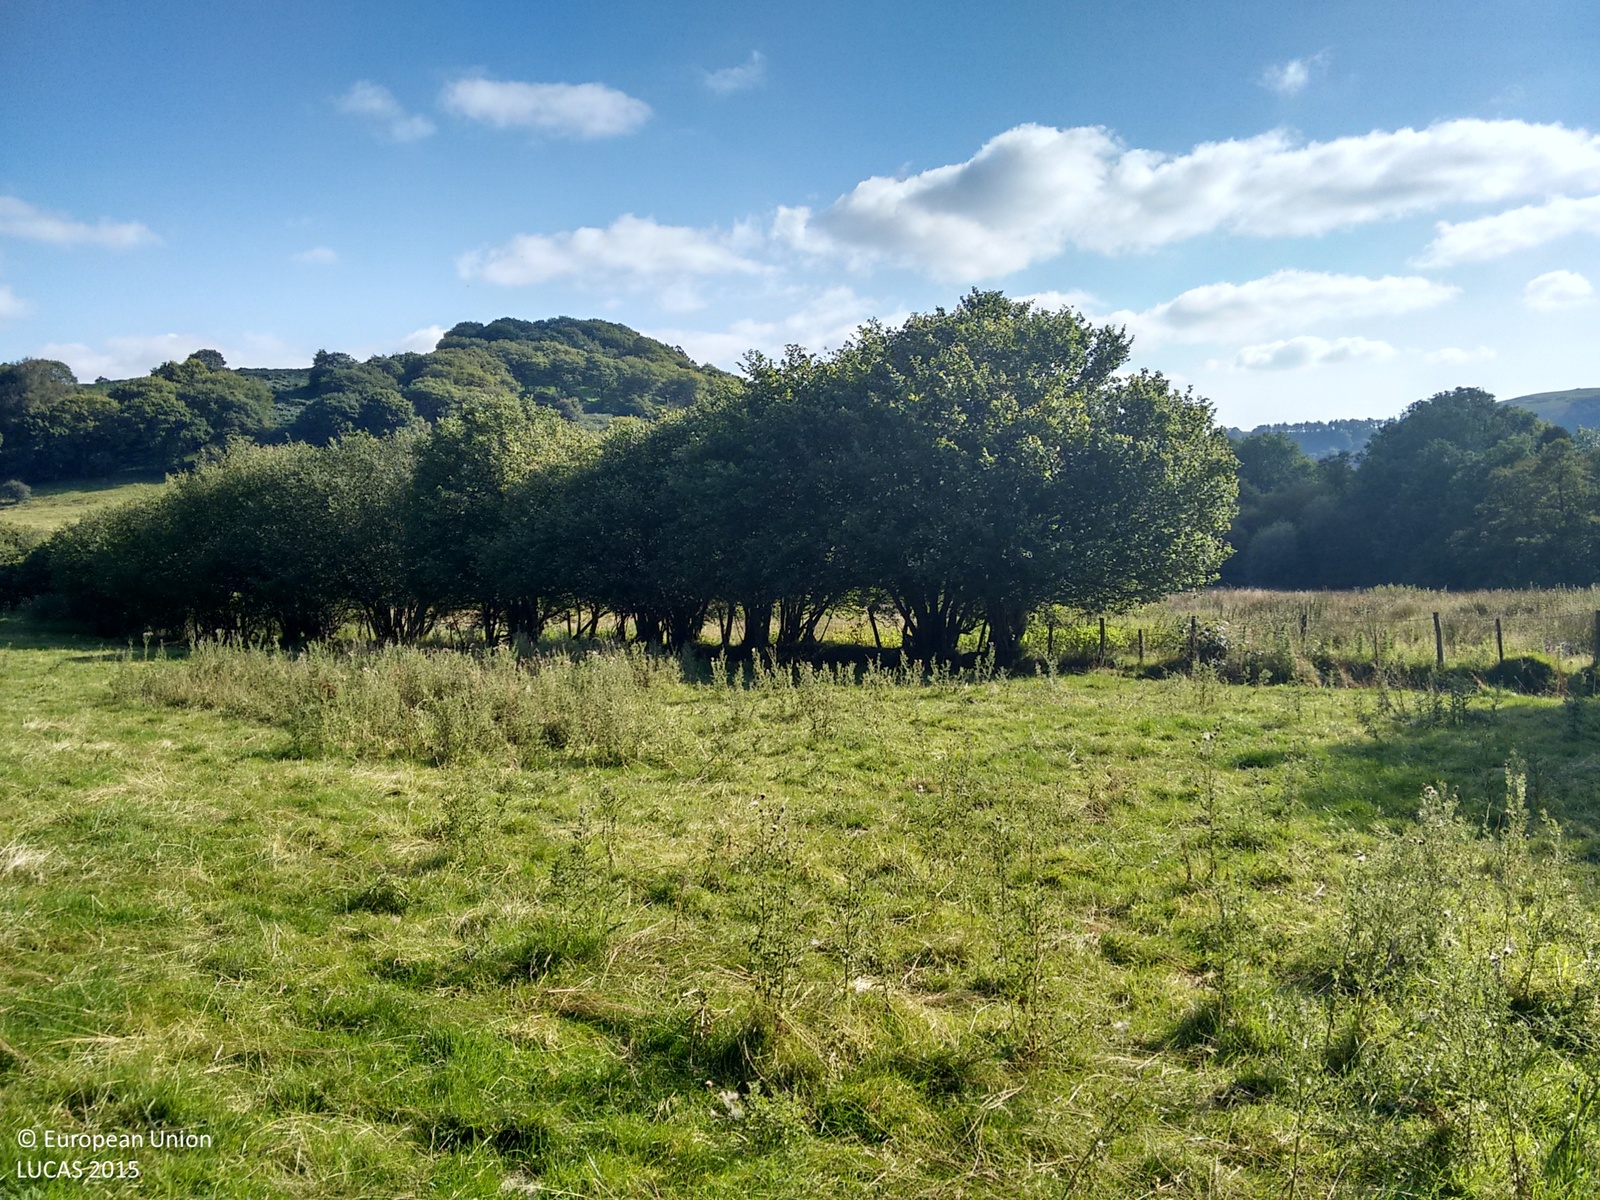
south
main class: Grassland
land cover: Grassland without tree/shrub cover
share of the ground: > 75 %
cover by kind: herbaceous plants 100 %
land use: Agriculture (excluding fallow land and kitchen gardens)
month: September
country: GB
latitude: 52.0304
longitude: -3.4197
